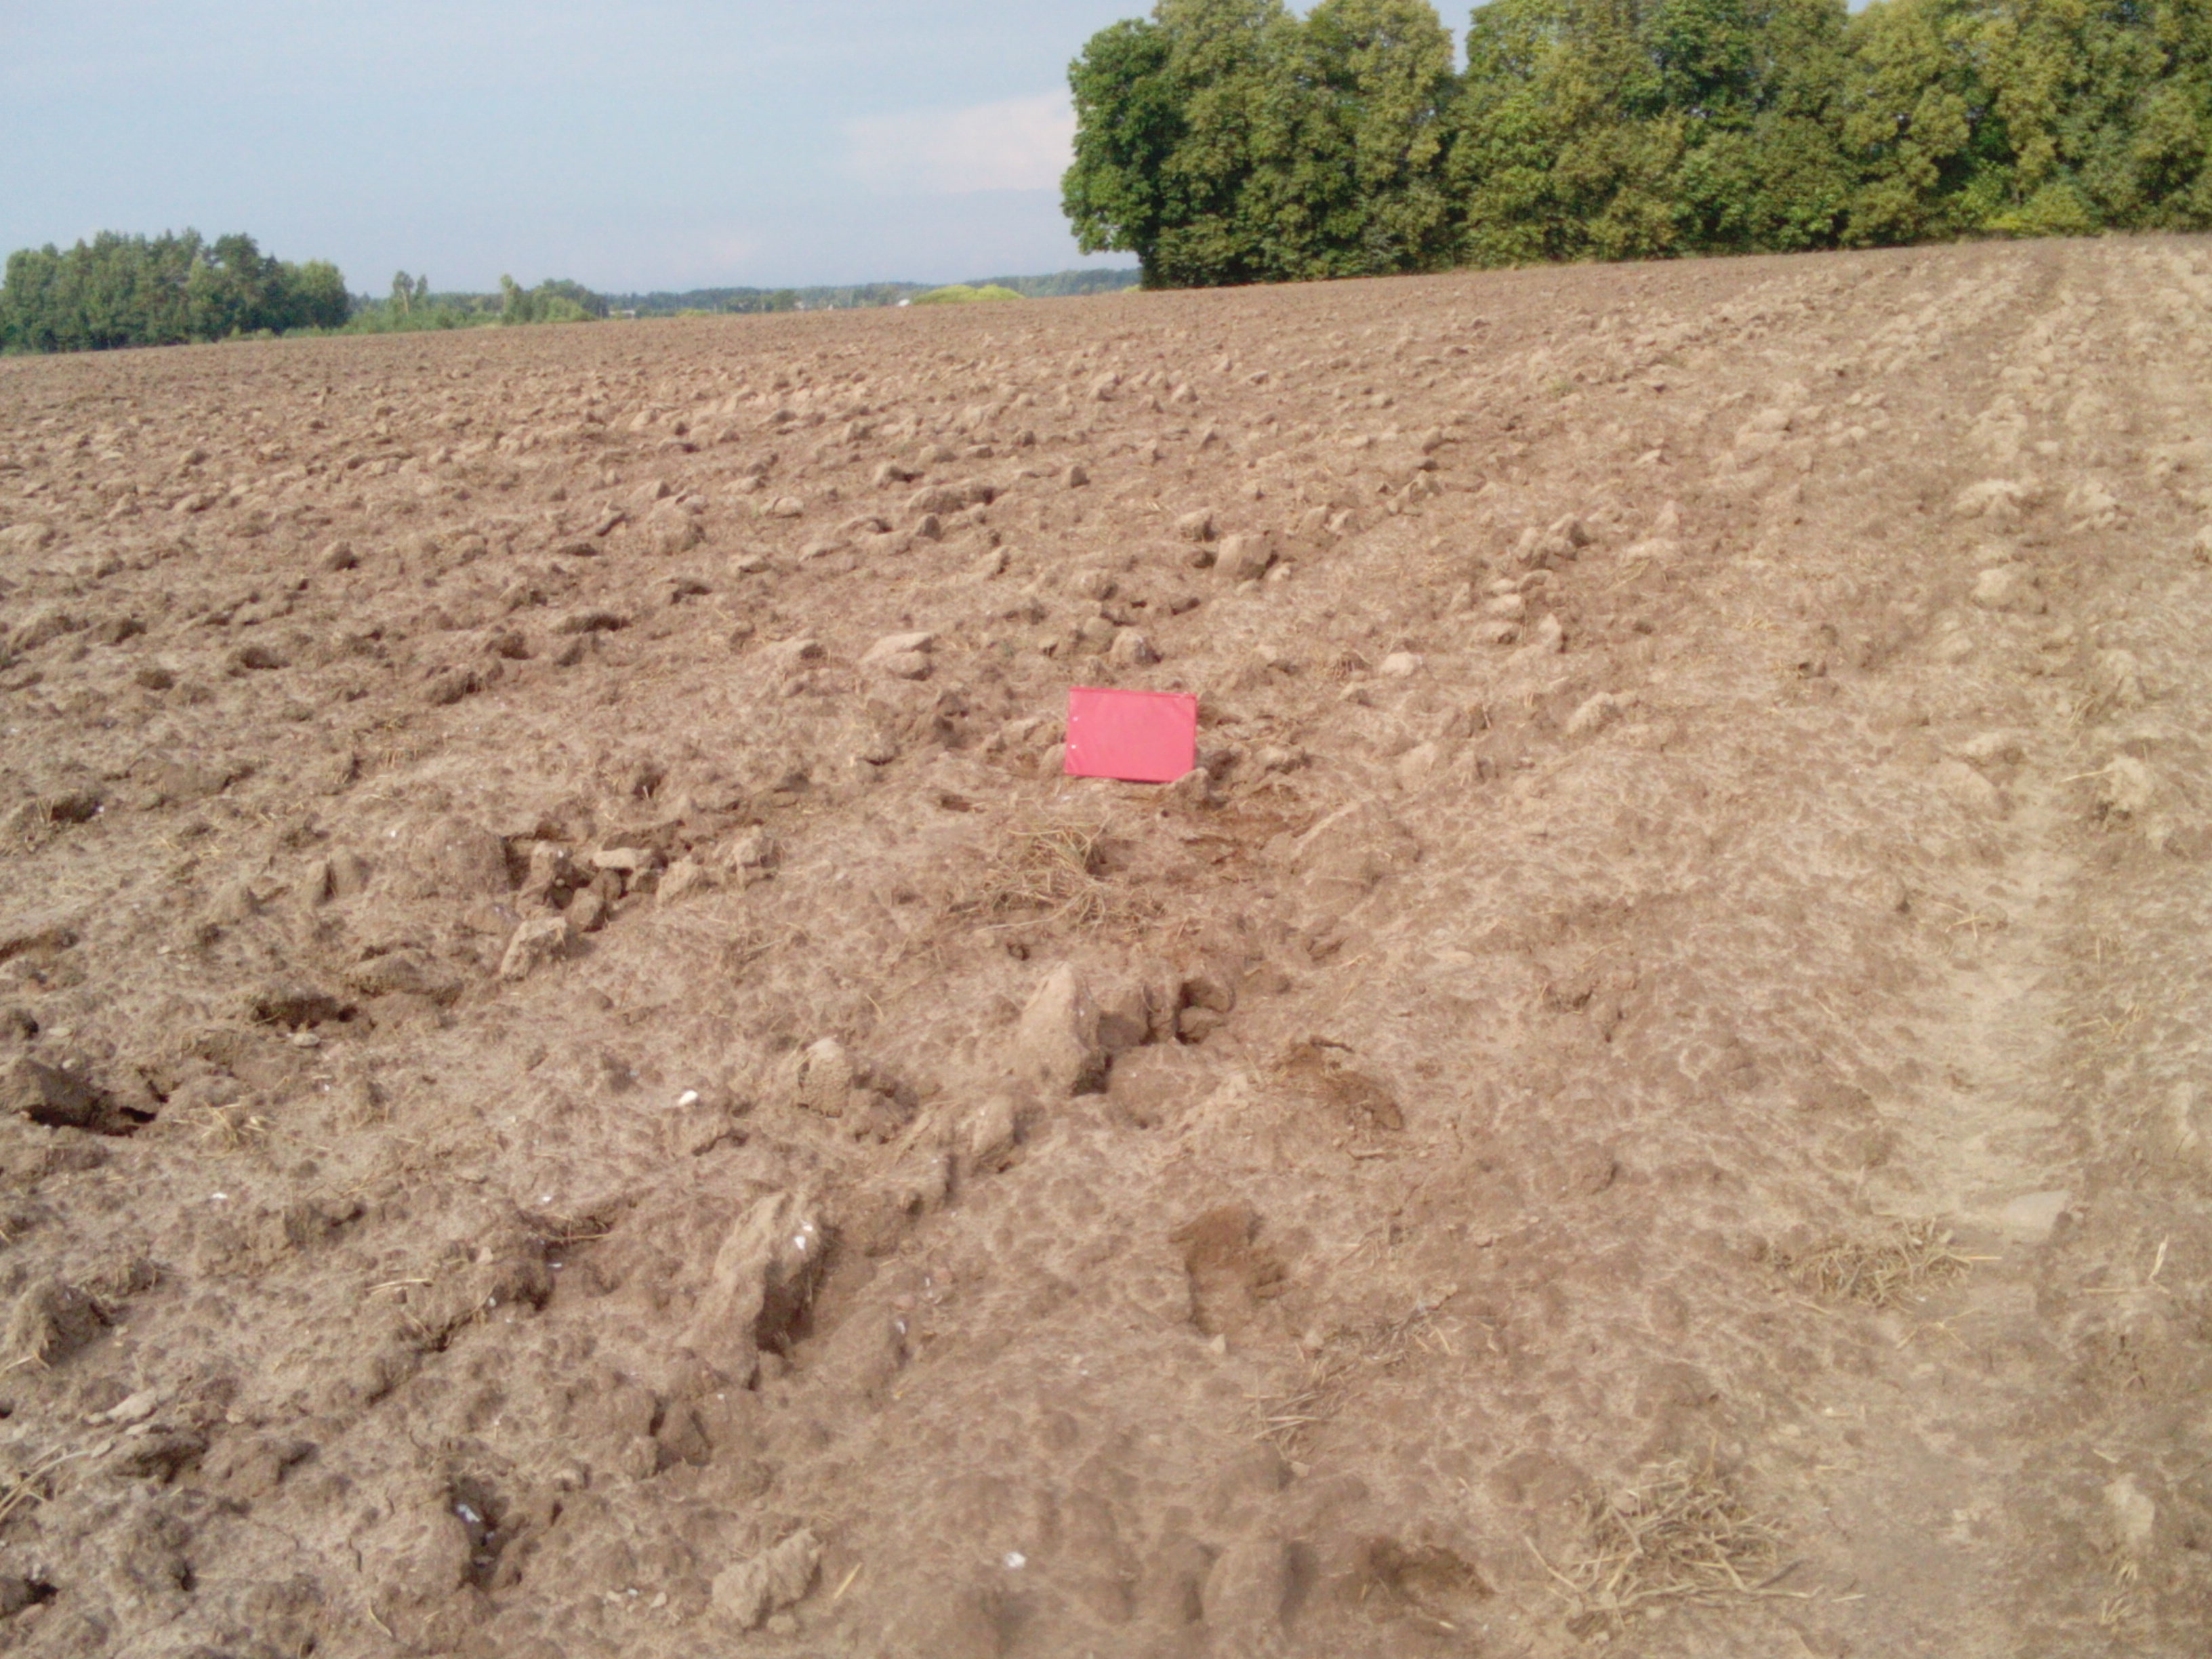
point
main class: Cropland
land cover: Dry pulses
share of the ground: < 10 %
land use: Agriculture (excluding fallow land and kitchen gardens)
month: September
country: LT
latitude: 55.7862
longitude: 22.7417
